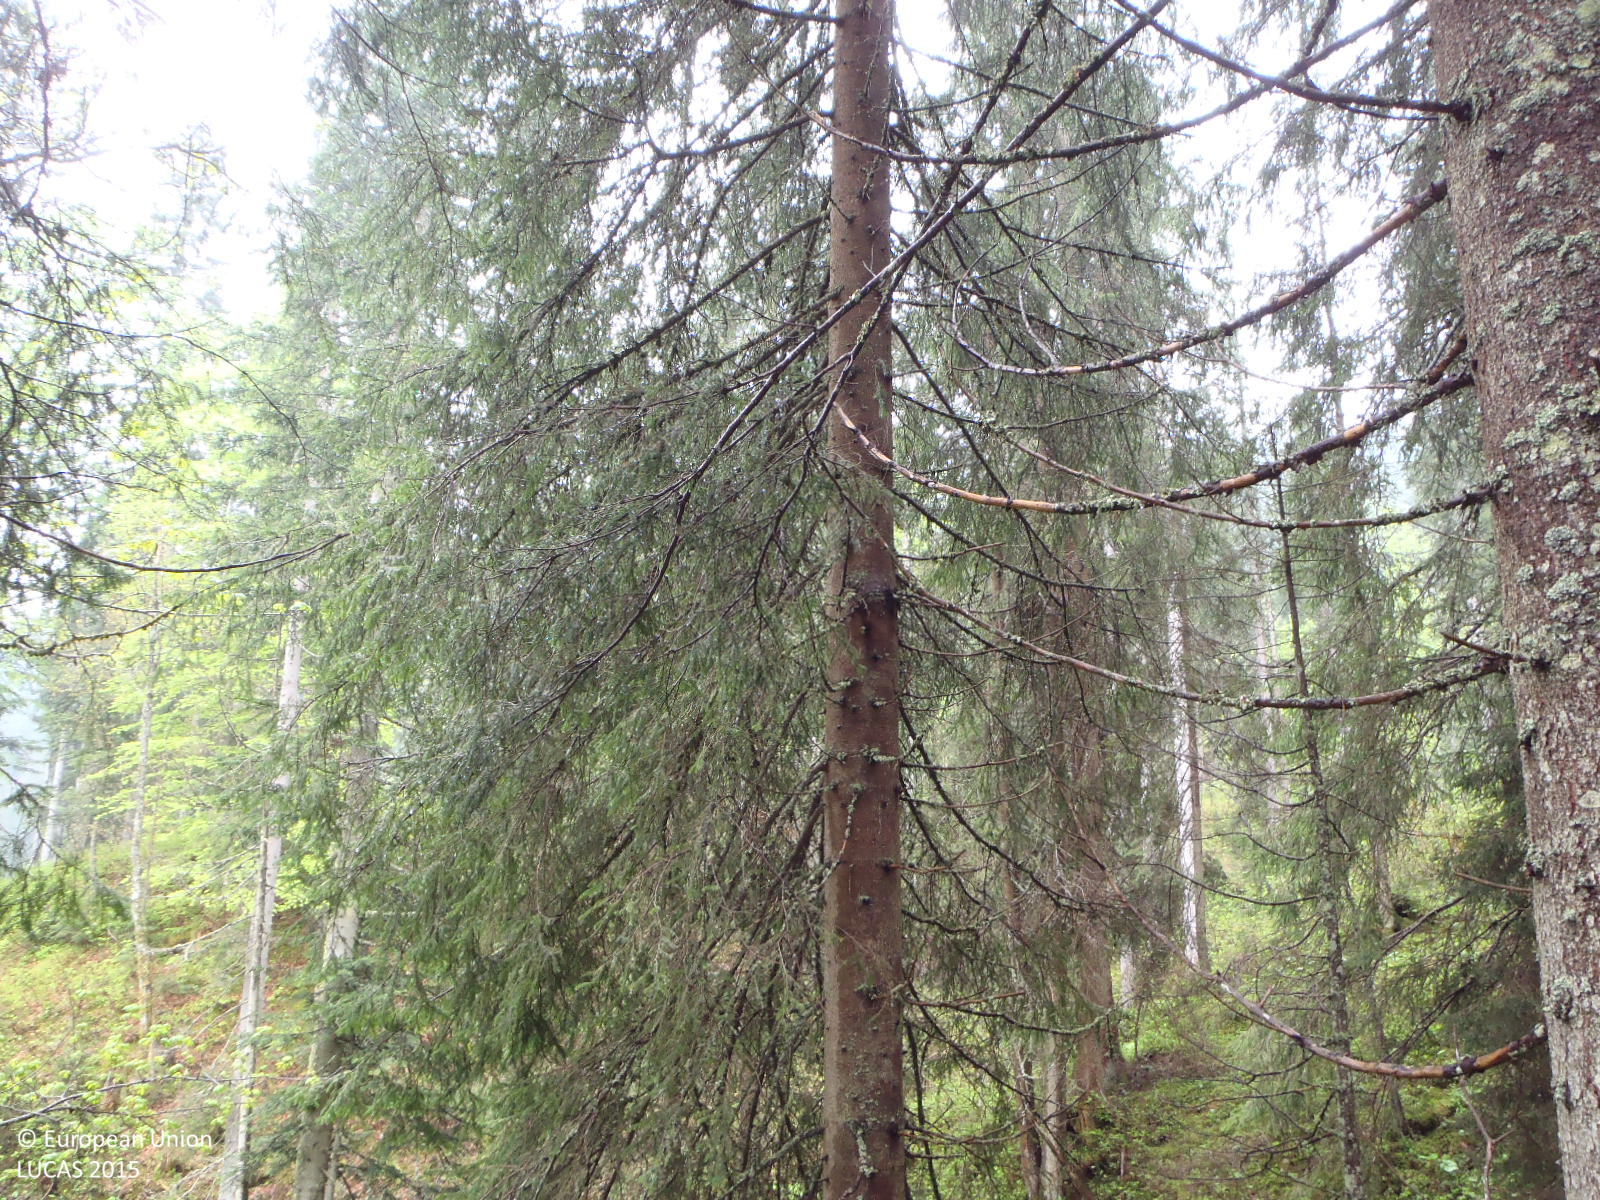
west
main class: Woodland
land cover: Spruce dominated coniferous woodland
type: alpine coniferous forest
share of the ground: > 75 %
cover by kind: coniferous forest trees 85 %, shrubs 5 %, herbaceous plants 5 %, lichens and mosses 5 %
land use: Forestry
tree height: > 5 m
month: May
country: AT
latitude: 47.6169
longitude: 12.5928
